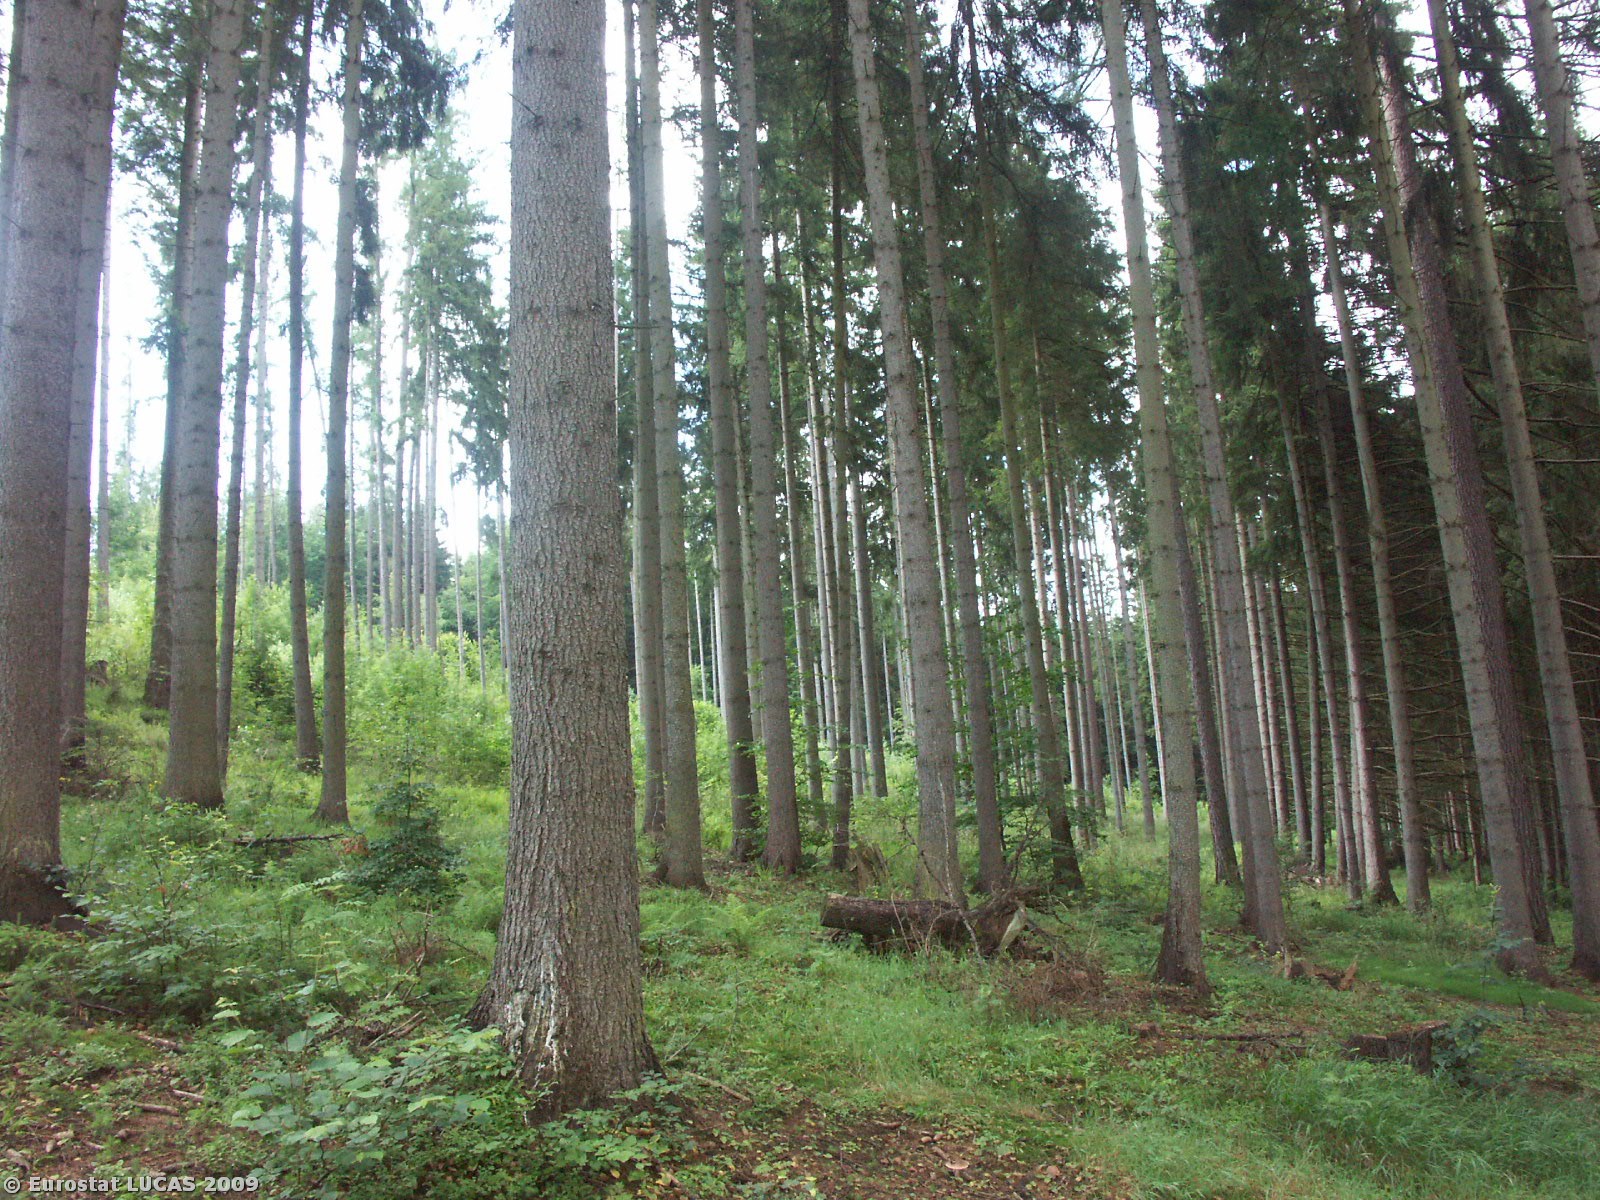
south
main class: Woodland
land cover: Coniferous woodland
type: hemiboreal forest and nemoral coniferous forest and mixed broadleaved-coniferous forest
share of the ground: > 75 %
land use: Forestry
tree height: > 5 m
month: July
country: CZ
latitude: 49.9429
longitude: 17.4111
